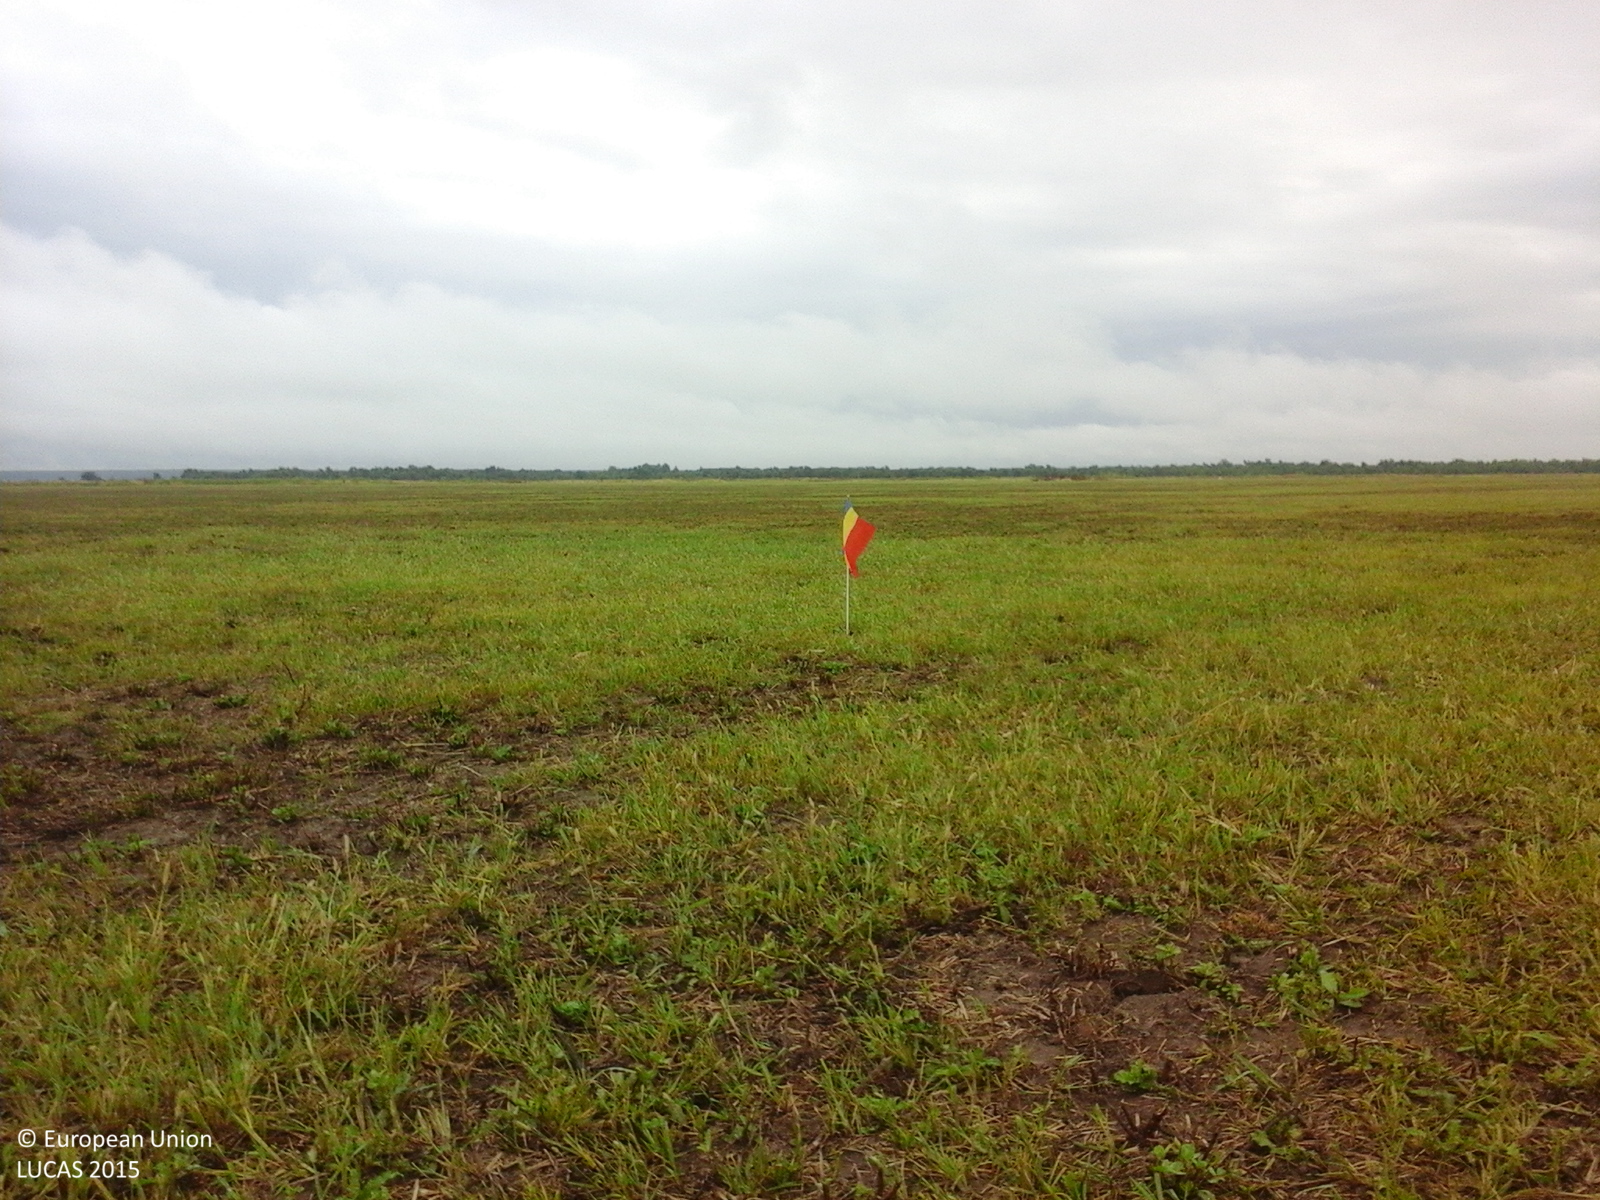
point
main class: Grassland
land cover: Grassland without tree/shrub cover
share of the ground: > 75 %
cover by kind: herbaceous plants 100 %
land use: Agriculture (excluding fallow land and kitchen gardens)
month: August
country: RO
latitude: 45.6362
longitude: 21.5148
